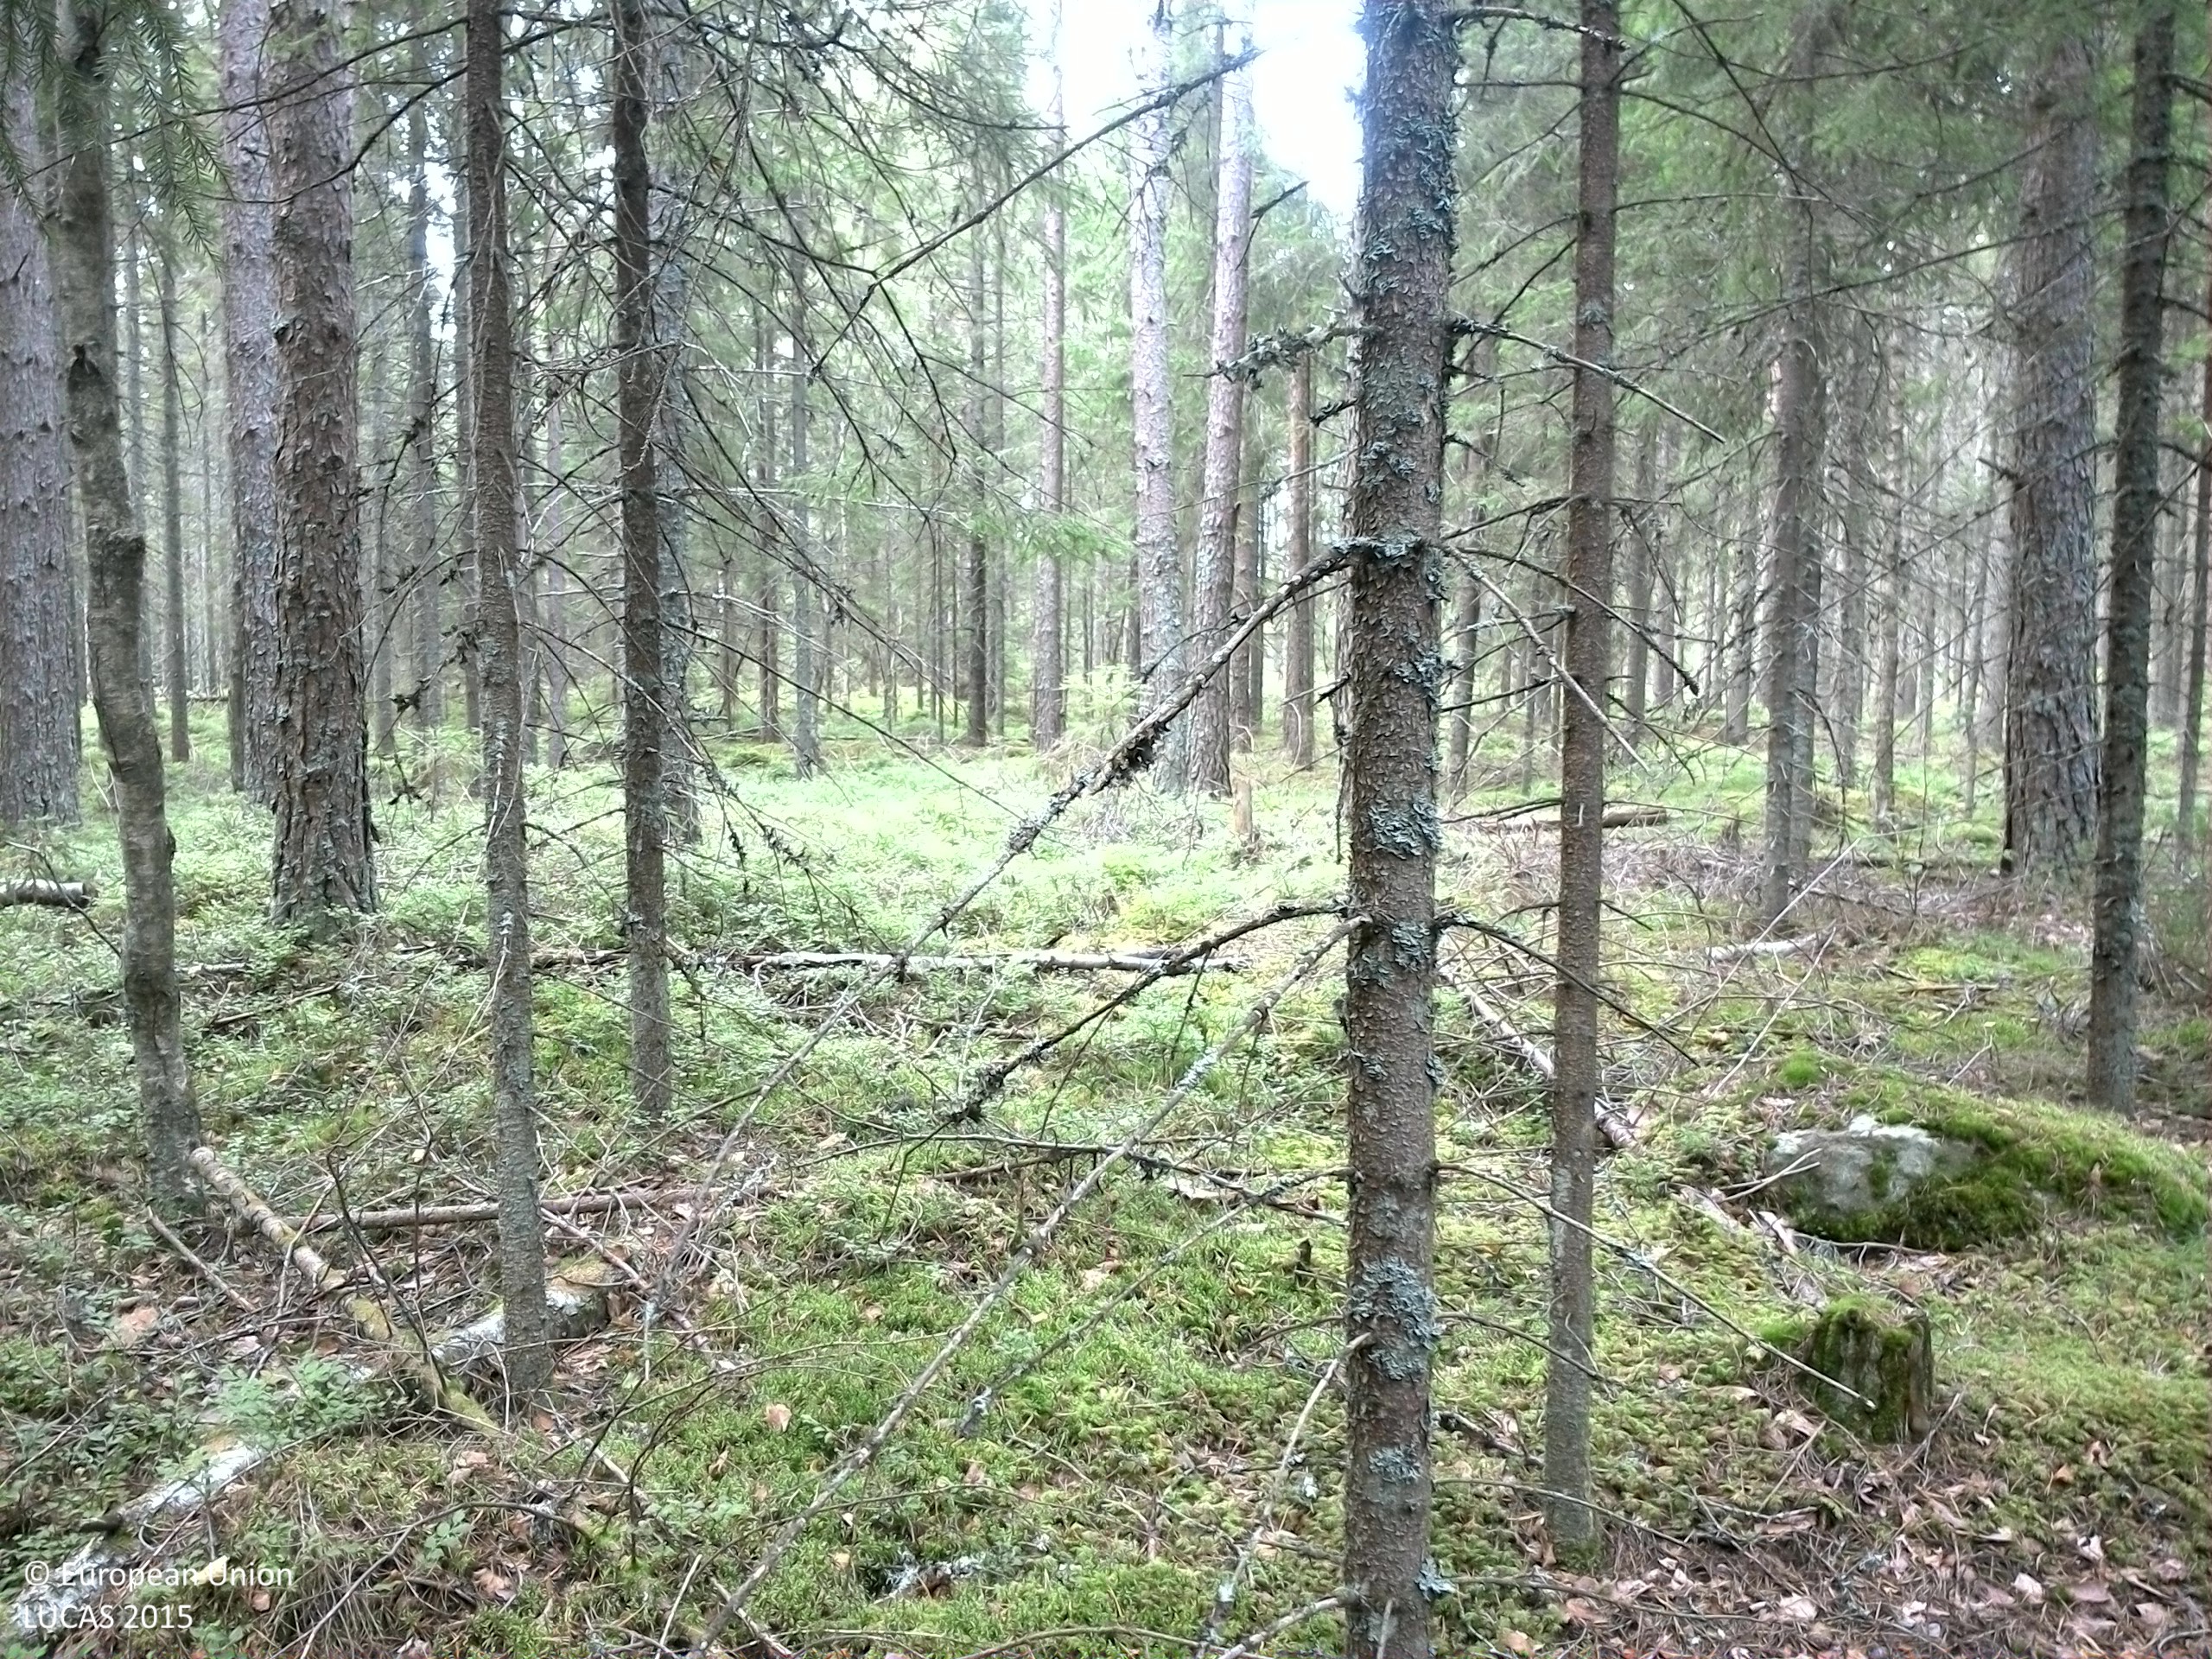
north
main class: Woodland
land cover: Spruce dominated coniferous woodland
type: boreal forest
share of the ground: 50 - 75 %
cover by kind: coniferous forest trees 65 %, shrubs 20 %, lichens and mosses 10 %, broadleaved forest trees 5 %
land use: Forestry
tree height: > 5 m
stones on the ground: < 10 %
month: September
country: SE
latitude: 59.7589
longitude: 13.4981
